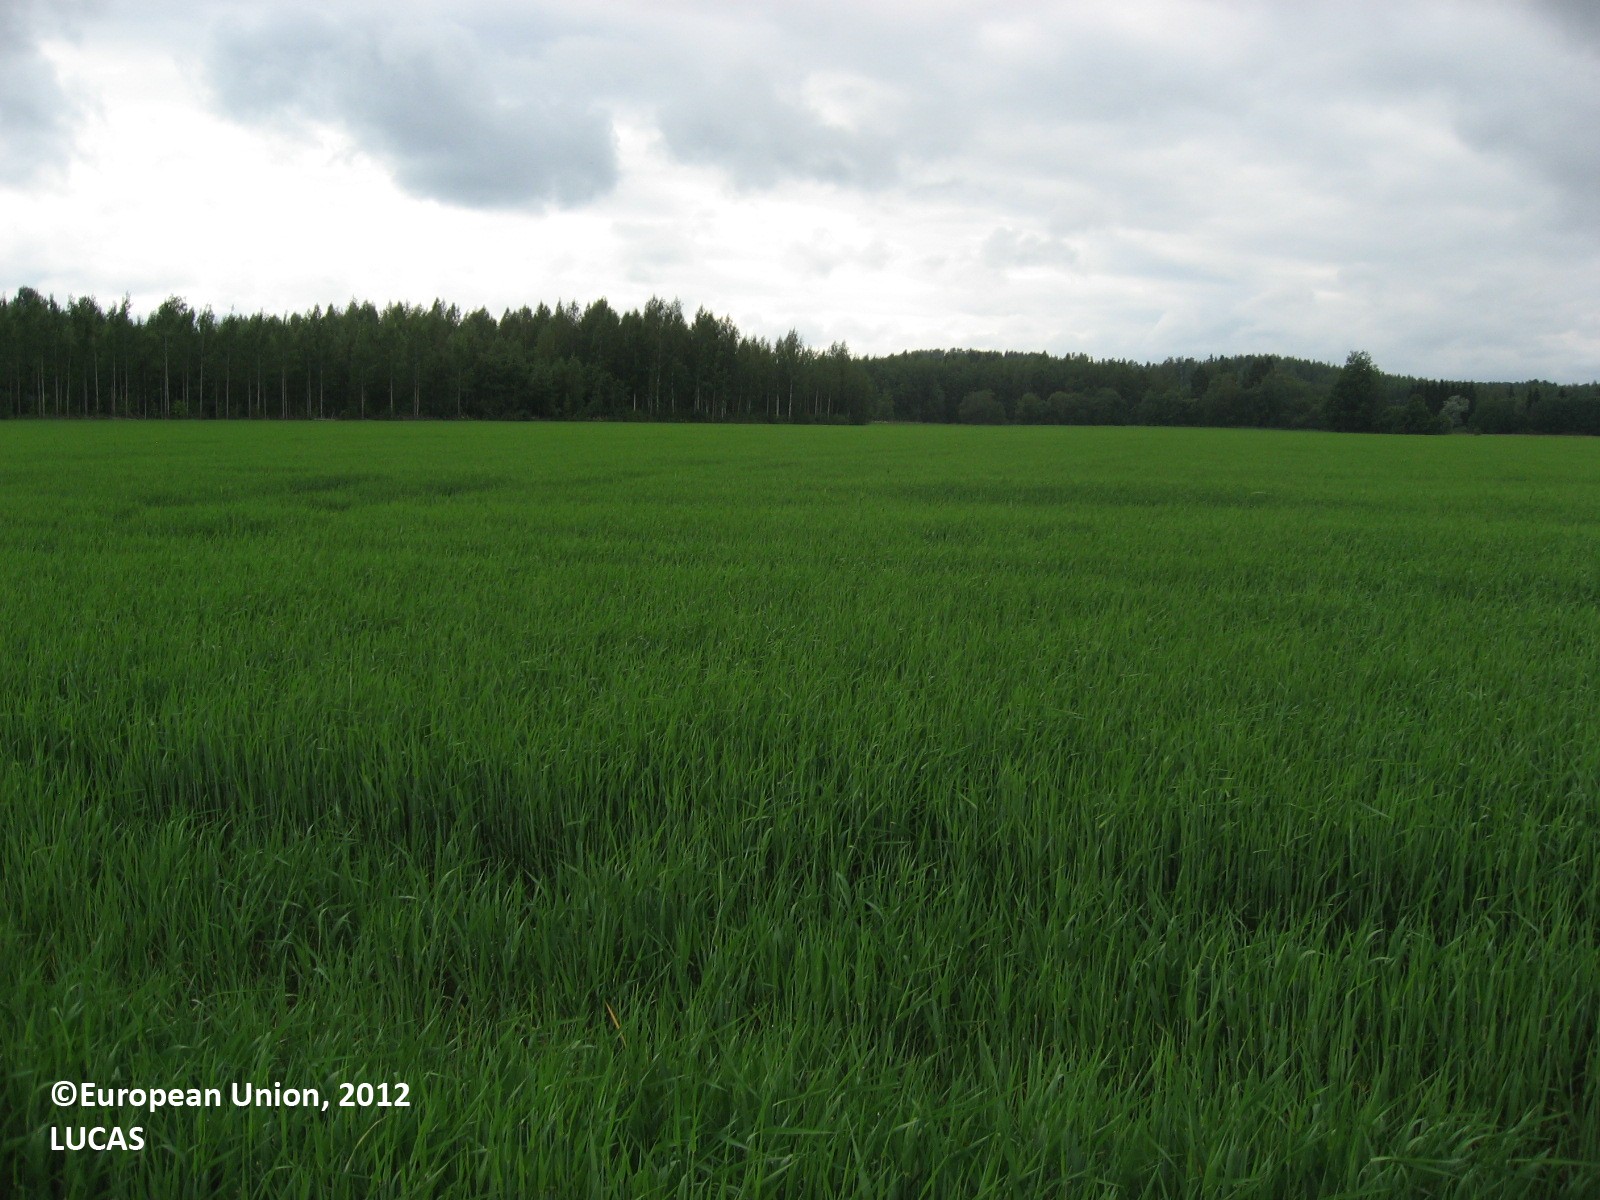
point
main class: Cropland
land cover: Barley
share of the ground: > 75 %
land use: Agriculture (excluding fallow land and kitchen gardens)
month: July
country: FI
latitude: 60.9204
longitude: 25.6416
